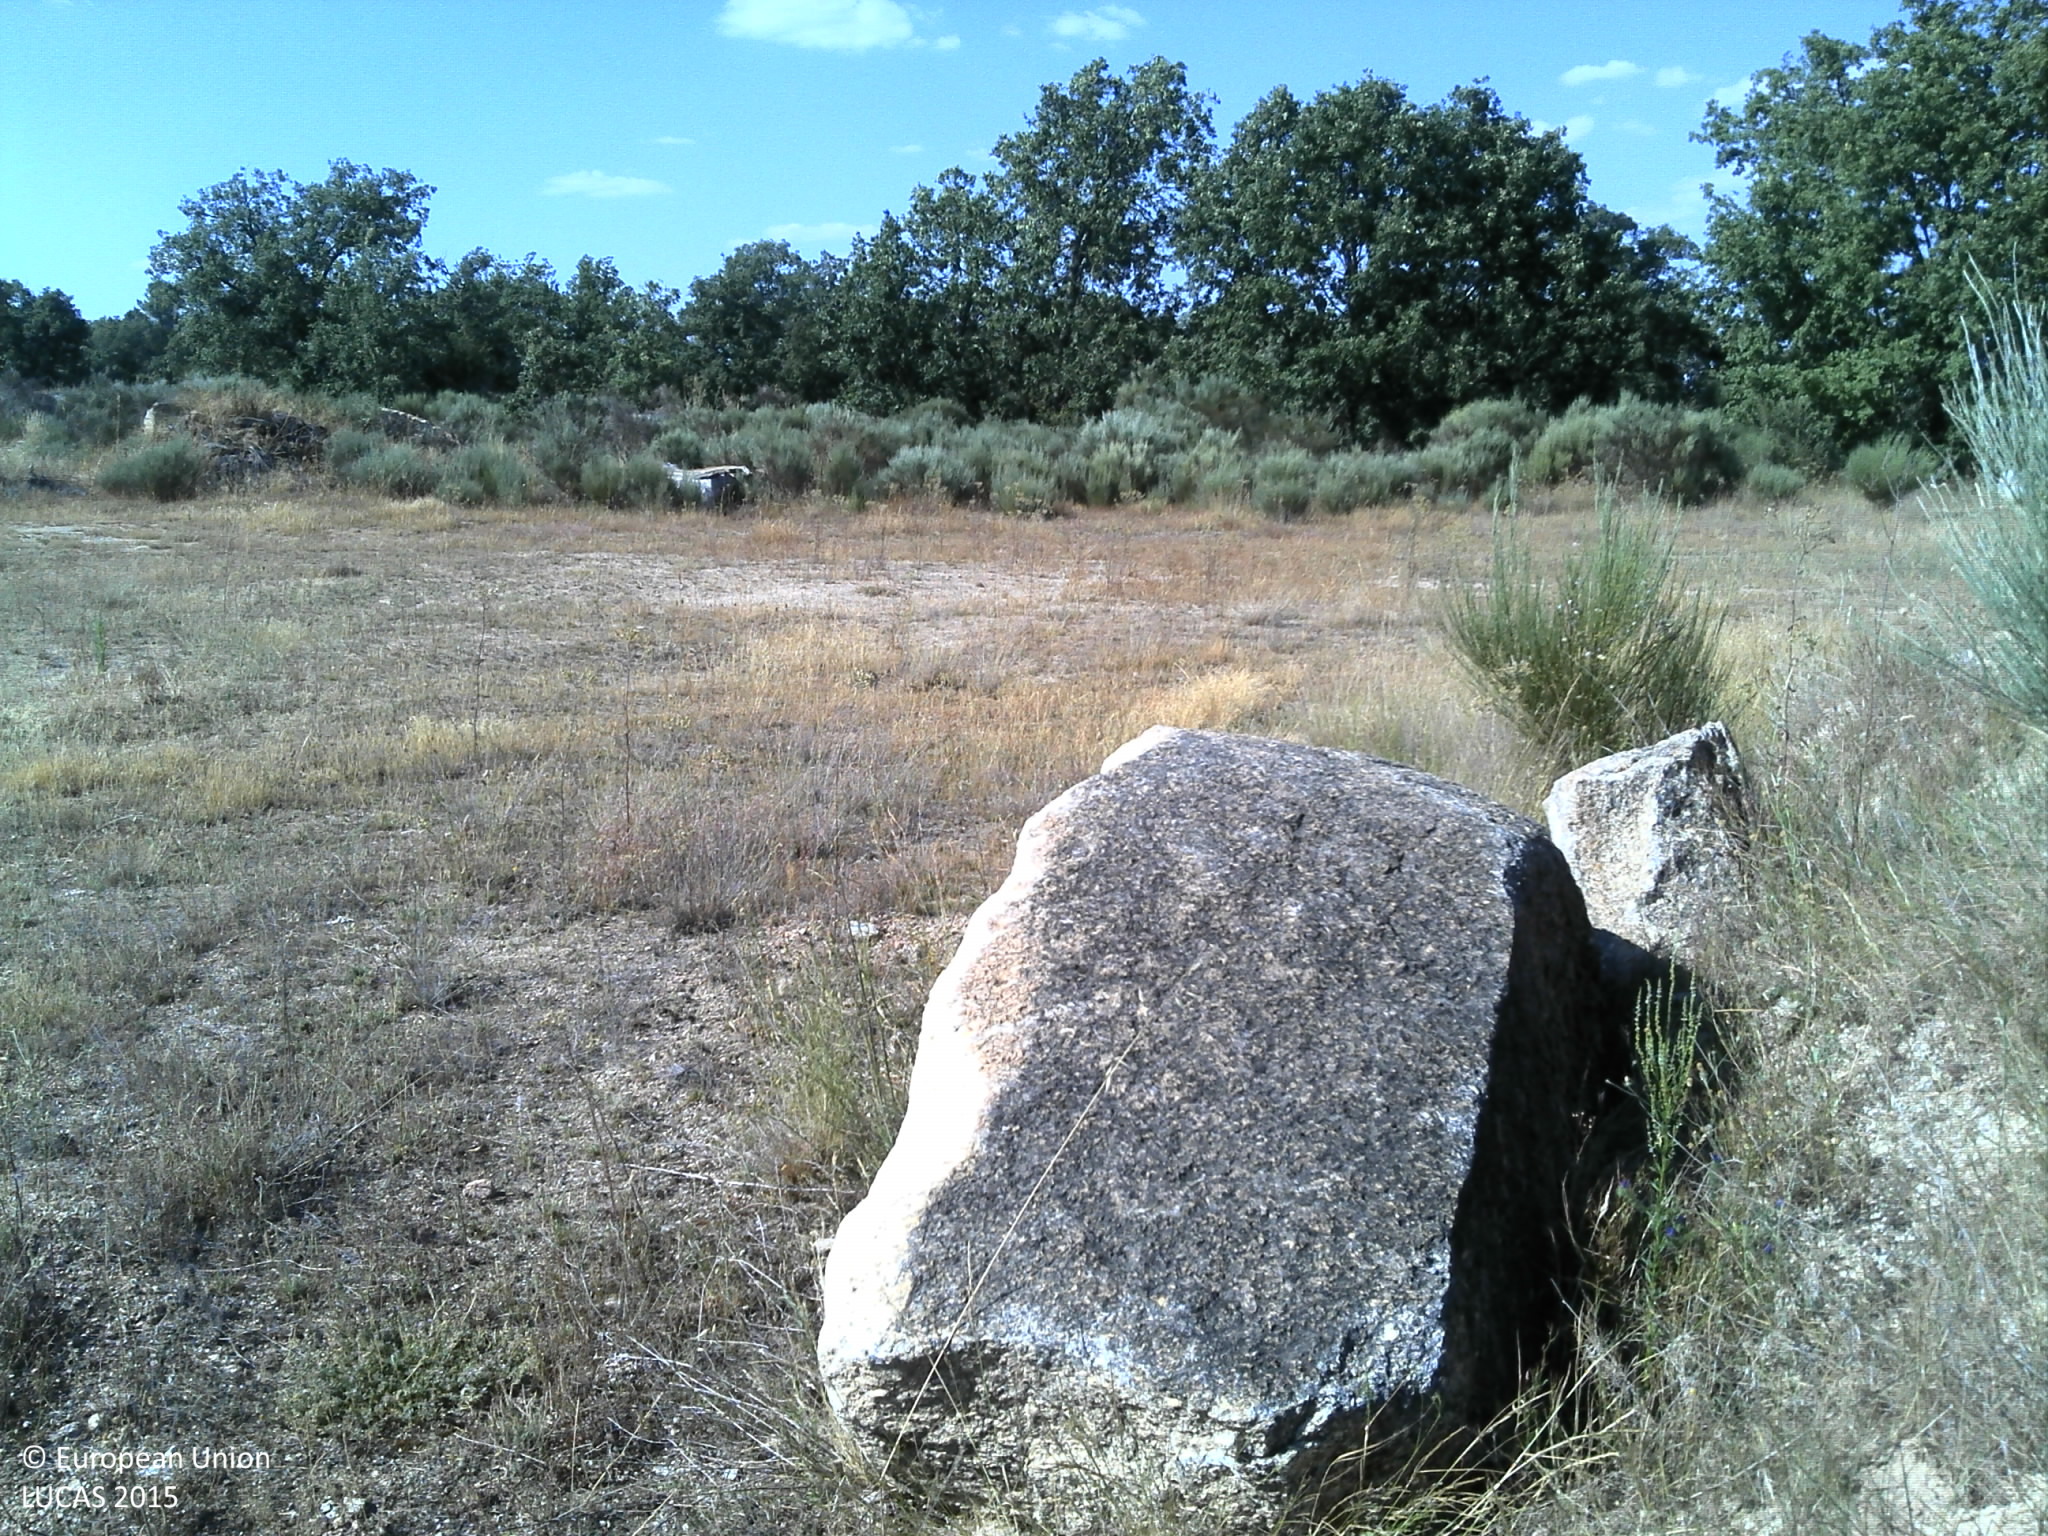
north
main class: Shrubland
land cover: Shrubland without tree cover
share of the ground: 25 - 50 %
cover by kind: unconsolidated bare surface 40 %, herbaceous plants 30 %, shrubs 25 %, consolidated bare surface 5 %
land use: Abandoned areas
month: June
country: PT
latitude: 40.7677
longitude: -6.8634
